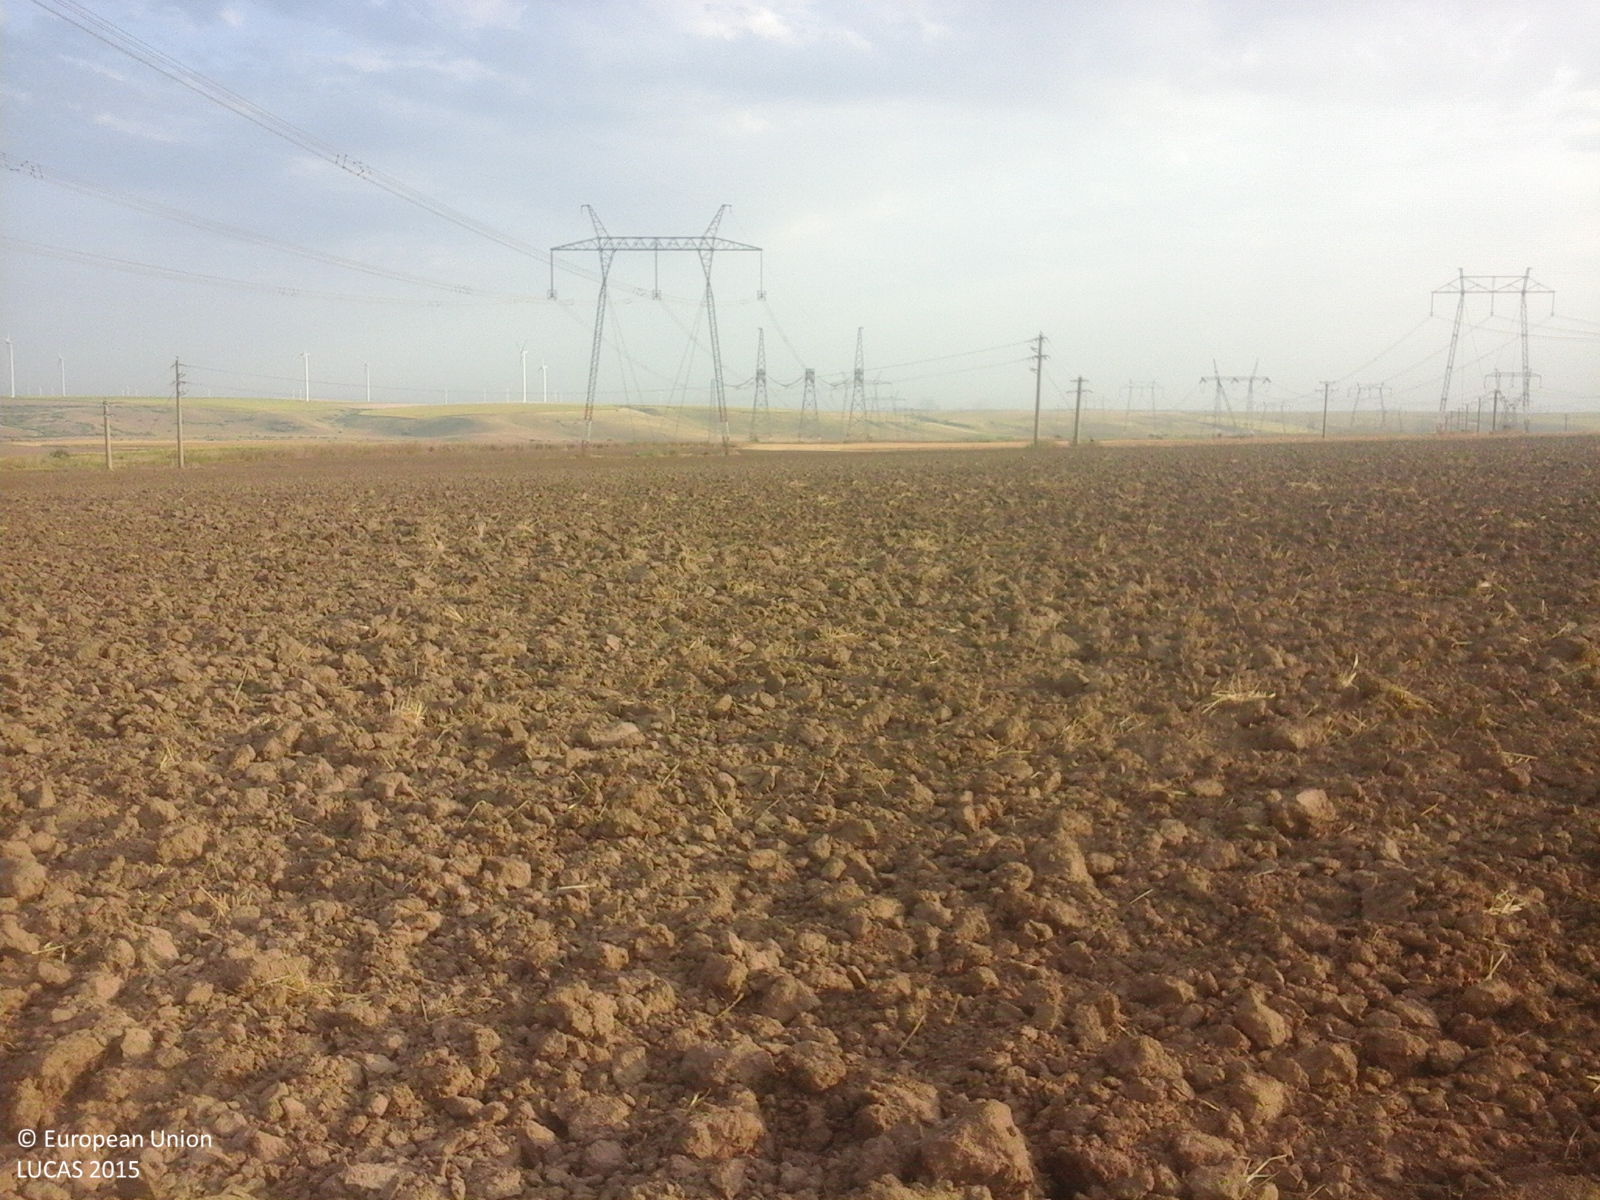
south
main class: Cropland
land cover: Common wheat
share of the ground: < 10 %
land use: Agriculture (excluding fallow land and kitchen gardens)
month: August
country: RO
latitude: 44.4111
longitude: 28.1572
